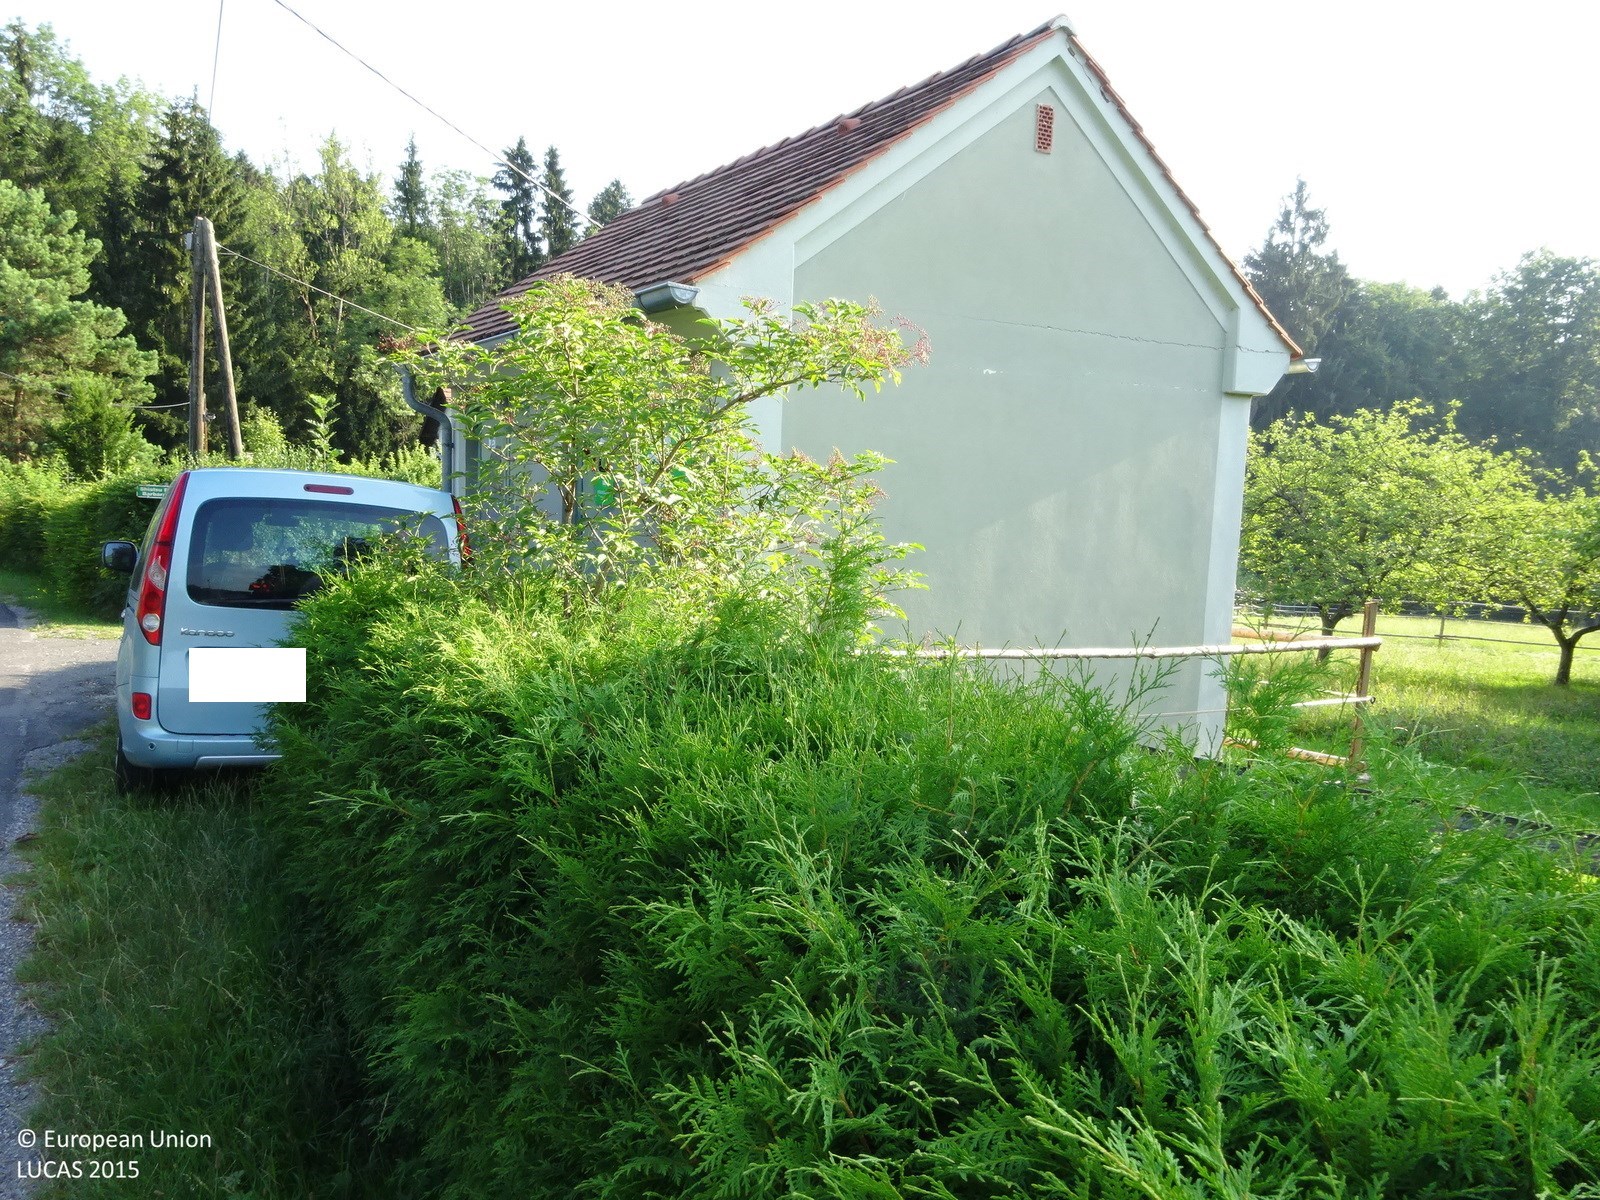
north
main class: Cropland
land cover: Apple fruit
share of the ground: > 75 %
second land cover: Grassland without tree/shrub cover
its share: > 75 %
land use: Agriculture (excluding fallow land and kitchen gardens)
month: July
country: AT
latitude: 47.1408
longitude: 15.2872
